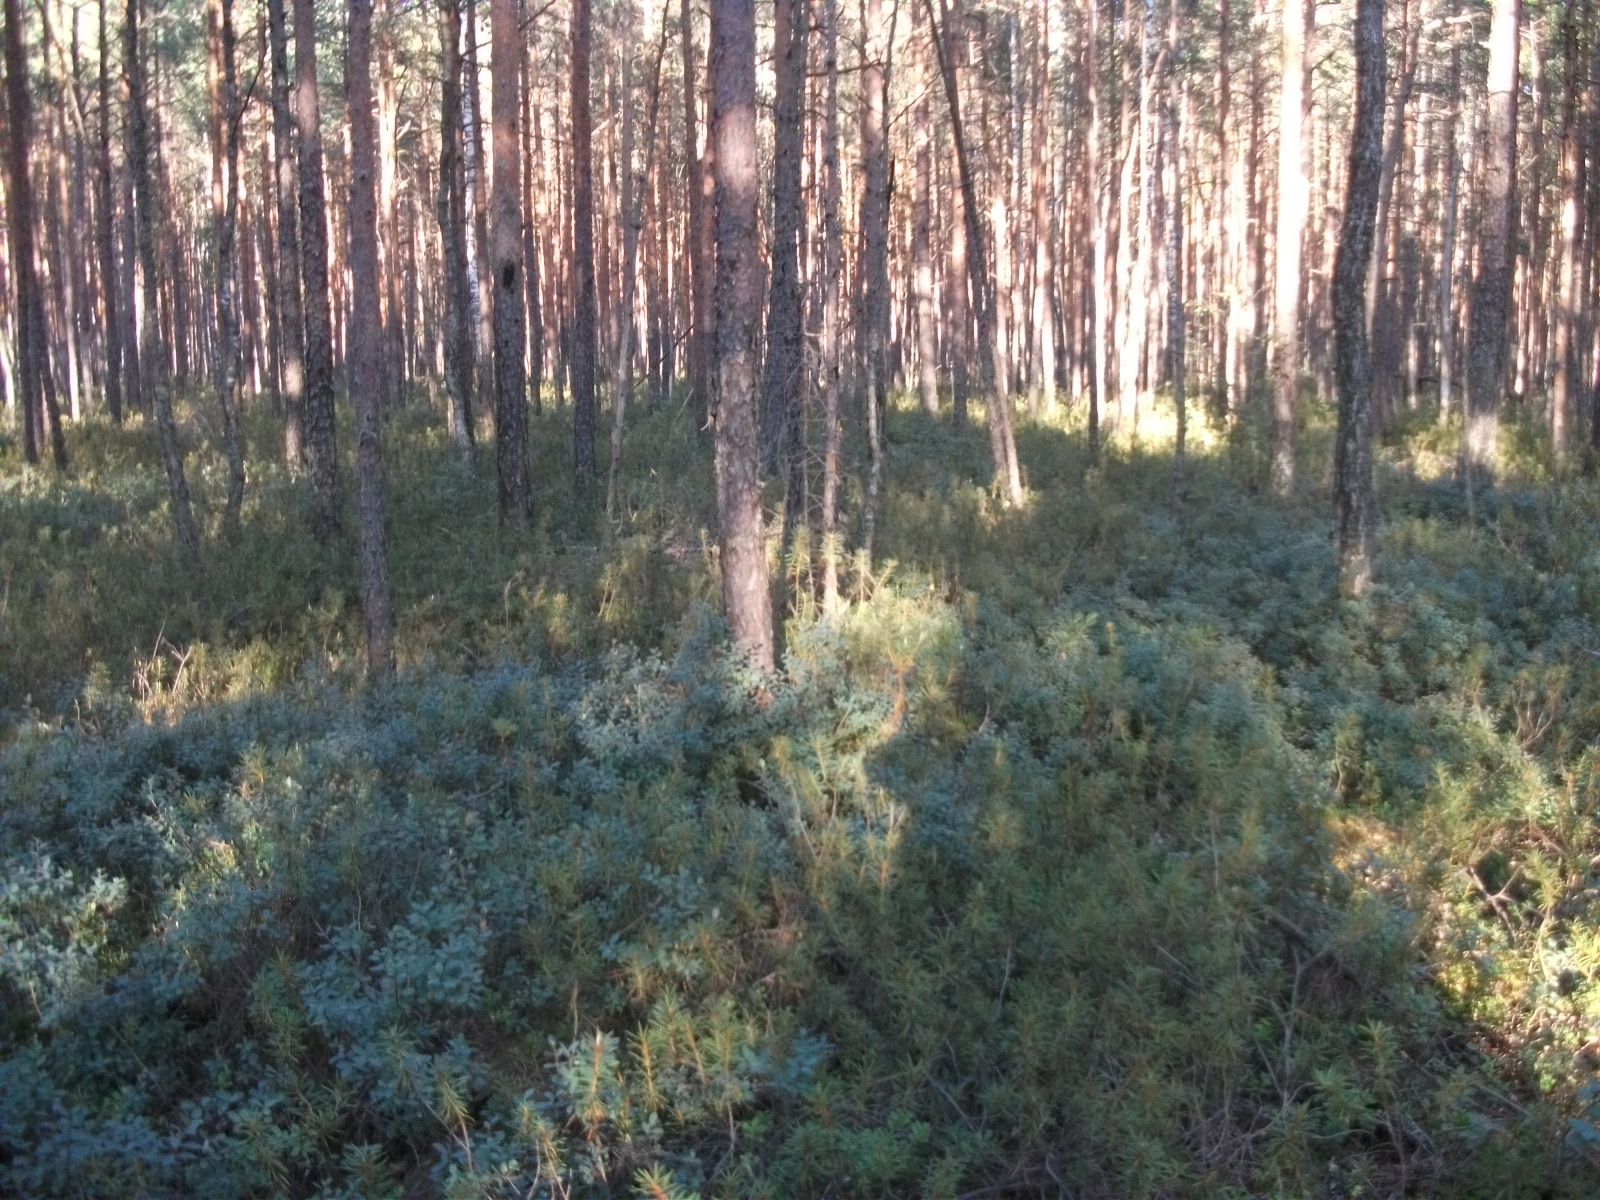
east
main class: Woodland
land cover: Pine dominated coniferous woodland
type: hemiboreal forest and nemoral coniferous forest and mixed broadleaved-coniferous forest
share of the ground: > 75 %
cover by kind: coniferous forest trees 85 %, lichens and mosses 15 %
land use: Forestry
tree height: > 5 m
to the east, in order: Pine dominated coniferous woodland; Pine dominated mixed woodland
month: August
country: LV
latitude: 56.5222
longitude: 26.3829
